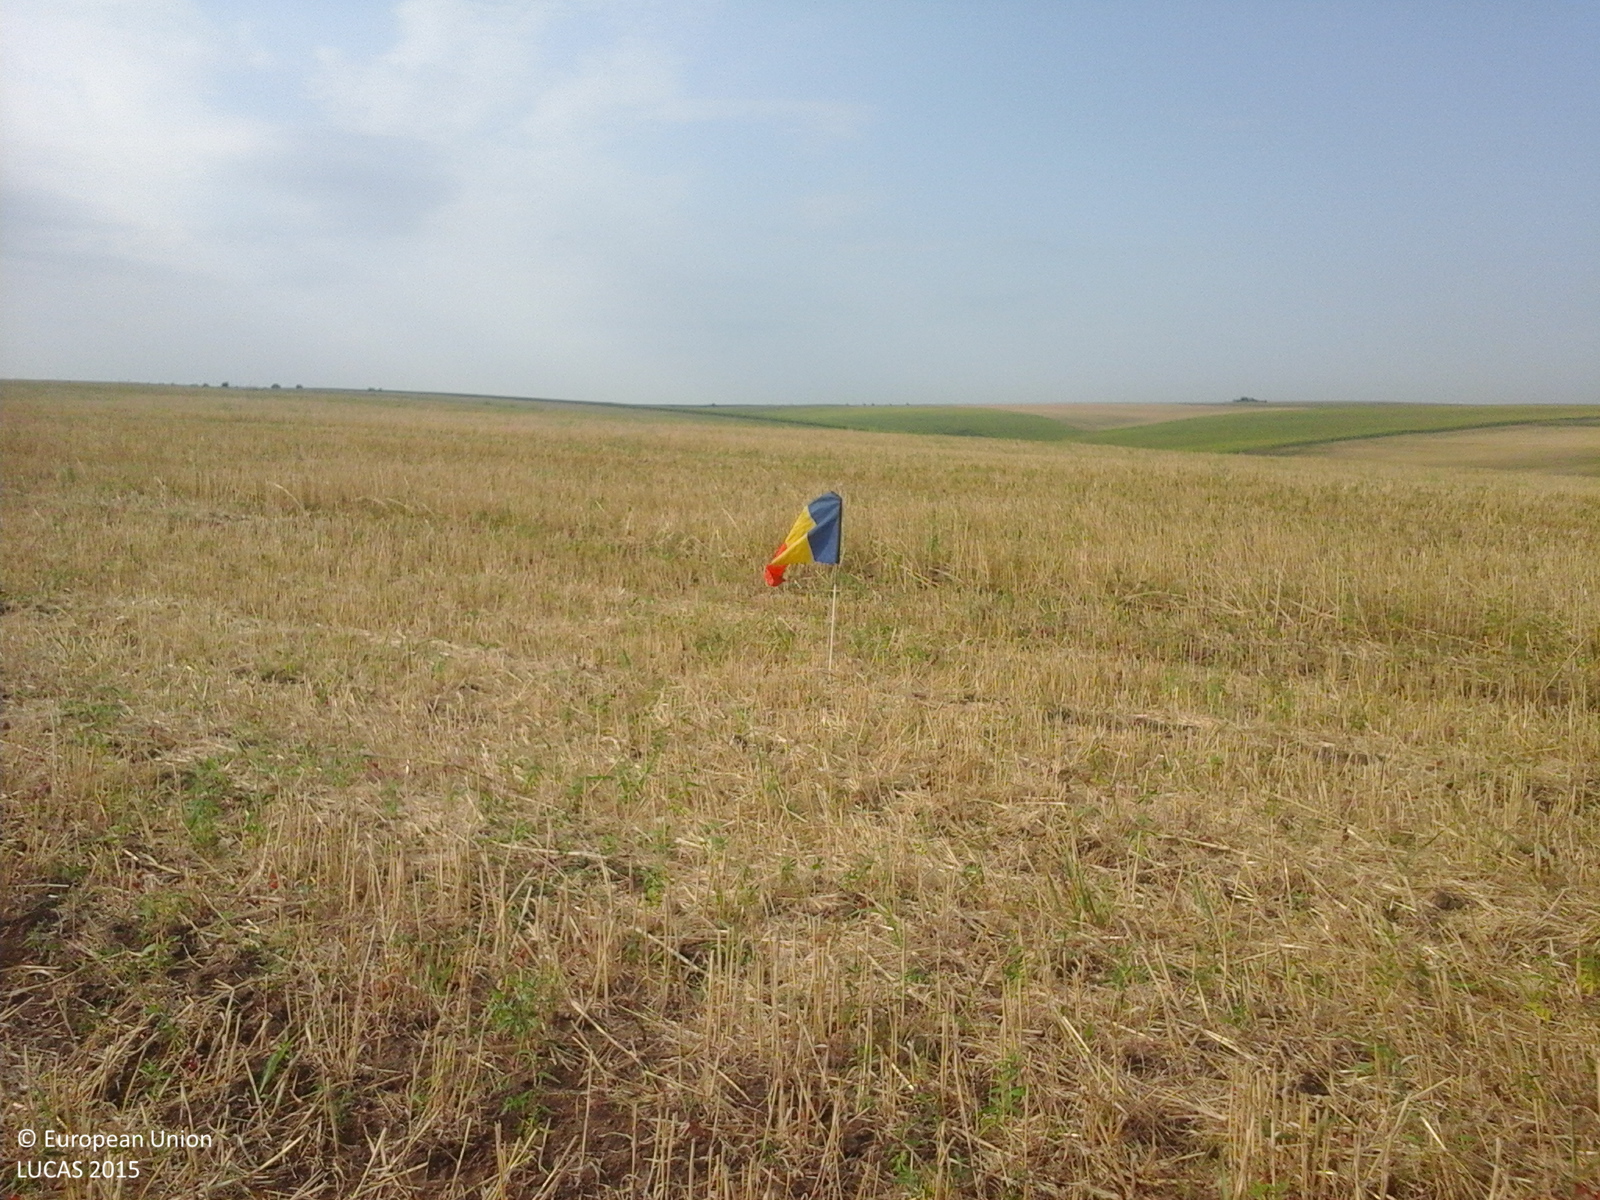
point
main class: Cropland
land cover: Barley
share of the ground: 50 - 75 %
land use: Agriculture (excluding fallow land and kitchen gardens)
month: August
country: RO
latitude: 44.0316
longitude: 27.9049
